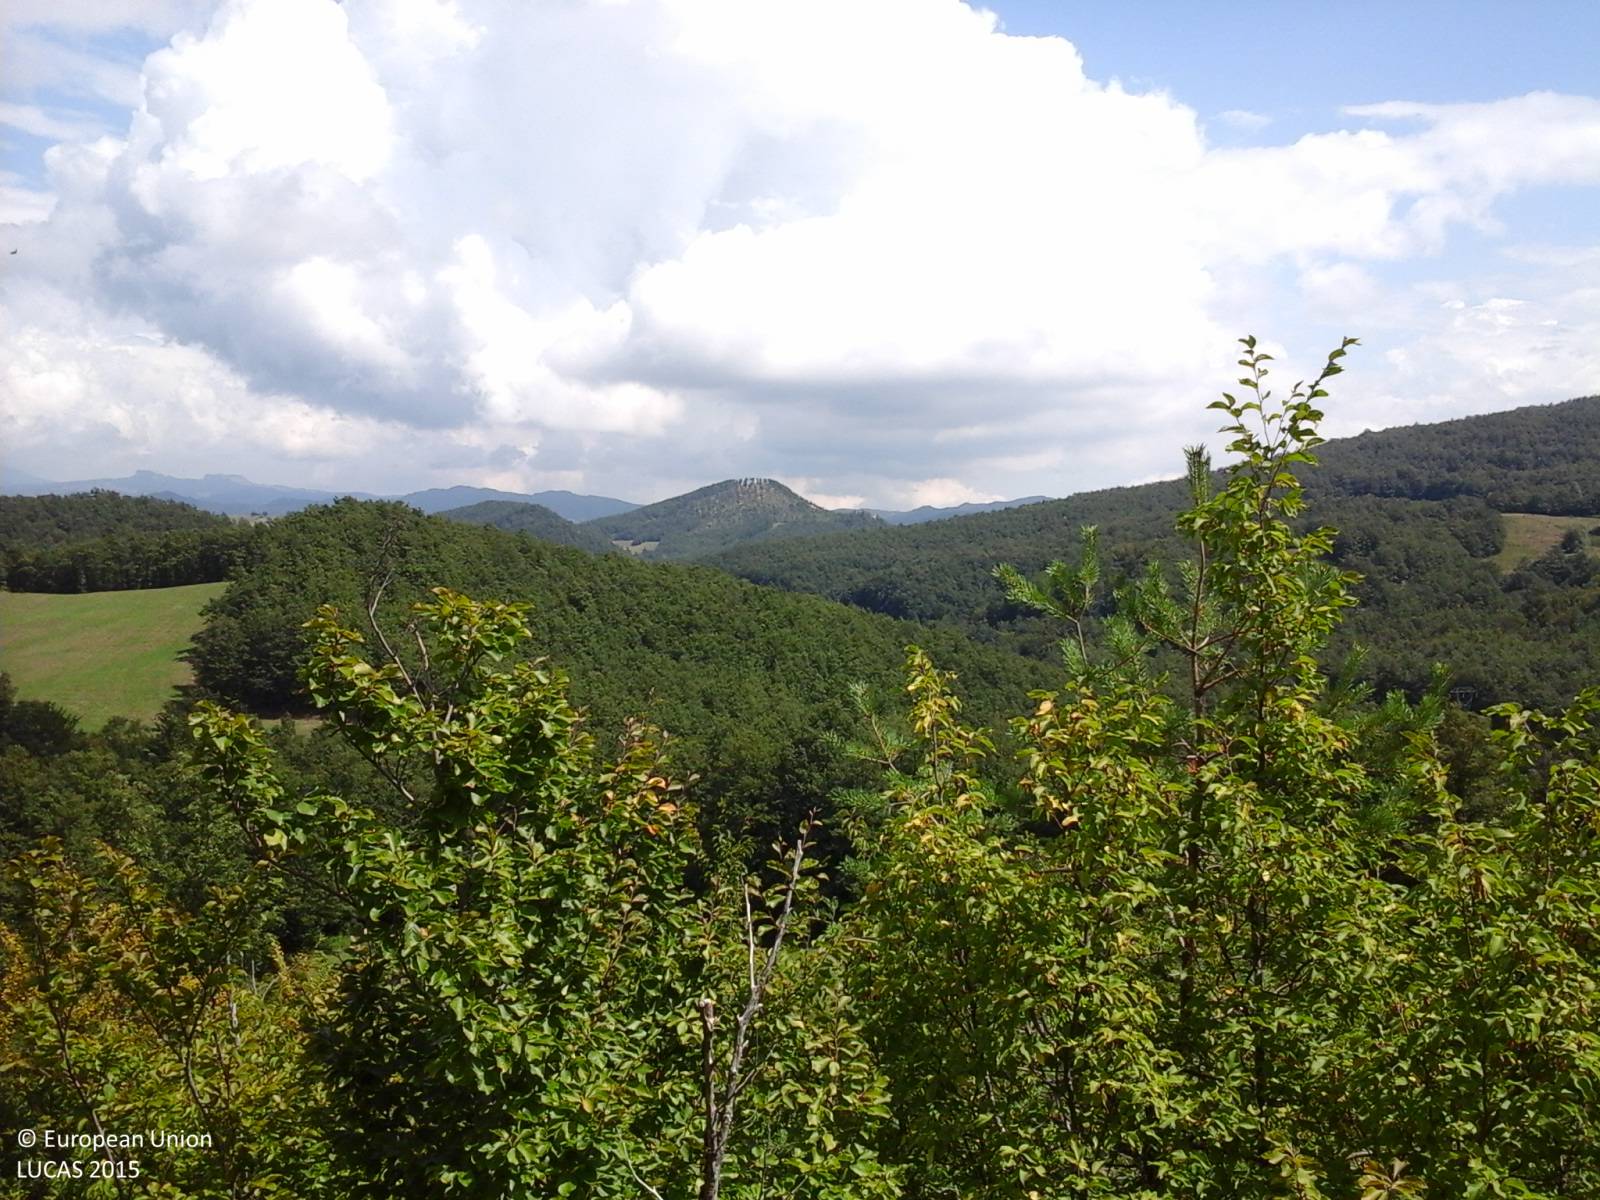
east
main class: Grassland
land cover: Grassland without tree/shrub cover
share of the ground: > 75 %
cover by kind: herbaceous plants 100 %
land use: Agriculture (excluding fallow land and kitchen gardens)
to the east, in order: Grassland without tree/shrub cover; Broadleaved woodland
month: August
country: IT
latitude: 43.6969
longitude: 12.1411
